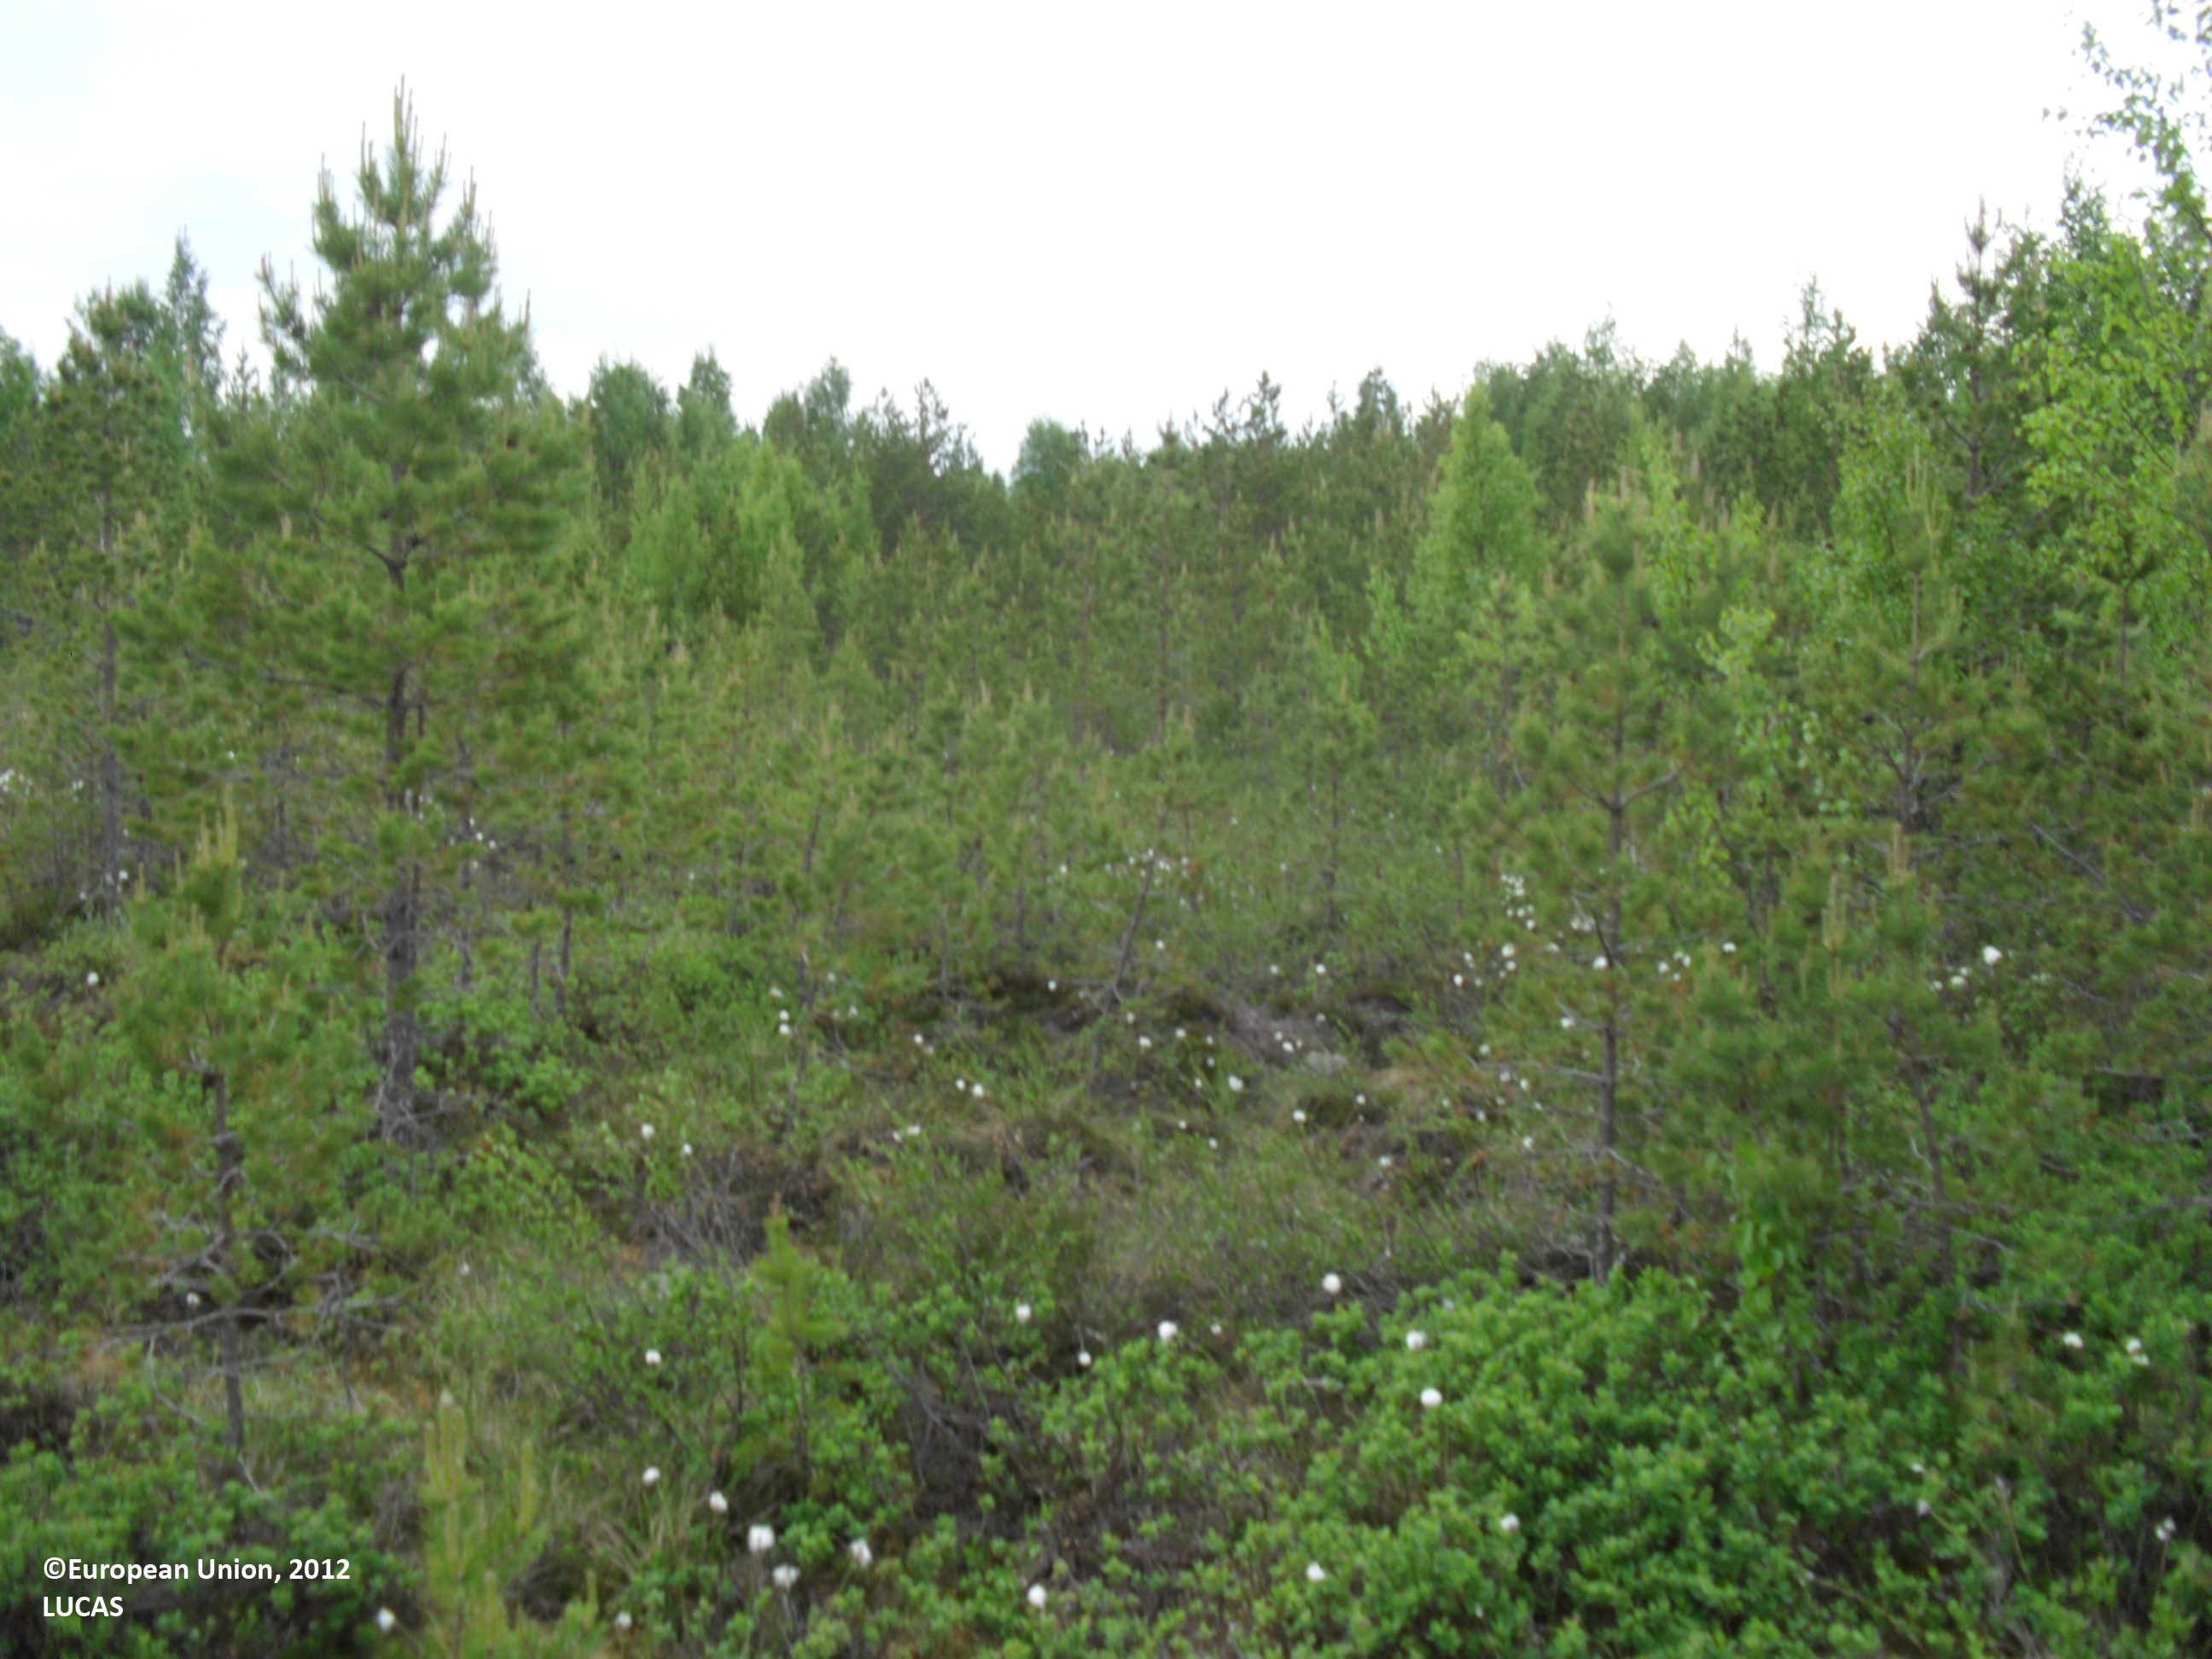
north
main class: Woodland
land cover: Pine dominated mixed woodland
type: mire and swamp forests
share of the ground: 10 - 25 %
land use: Forestry
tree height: < 5 m
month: June
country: FI
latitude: 62.9977
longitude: 23.4309
